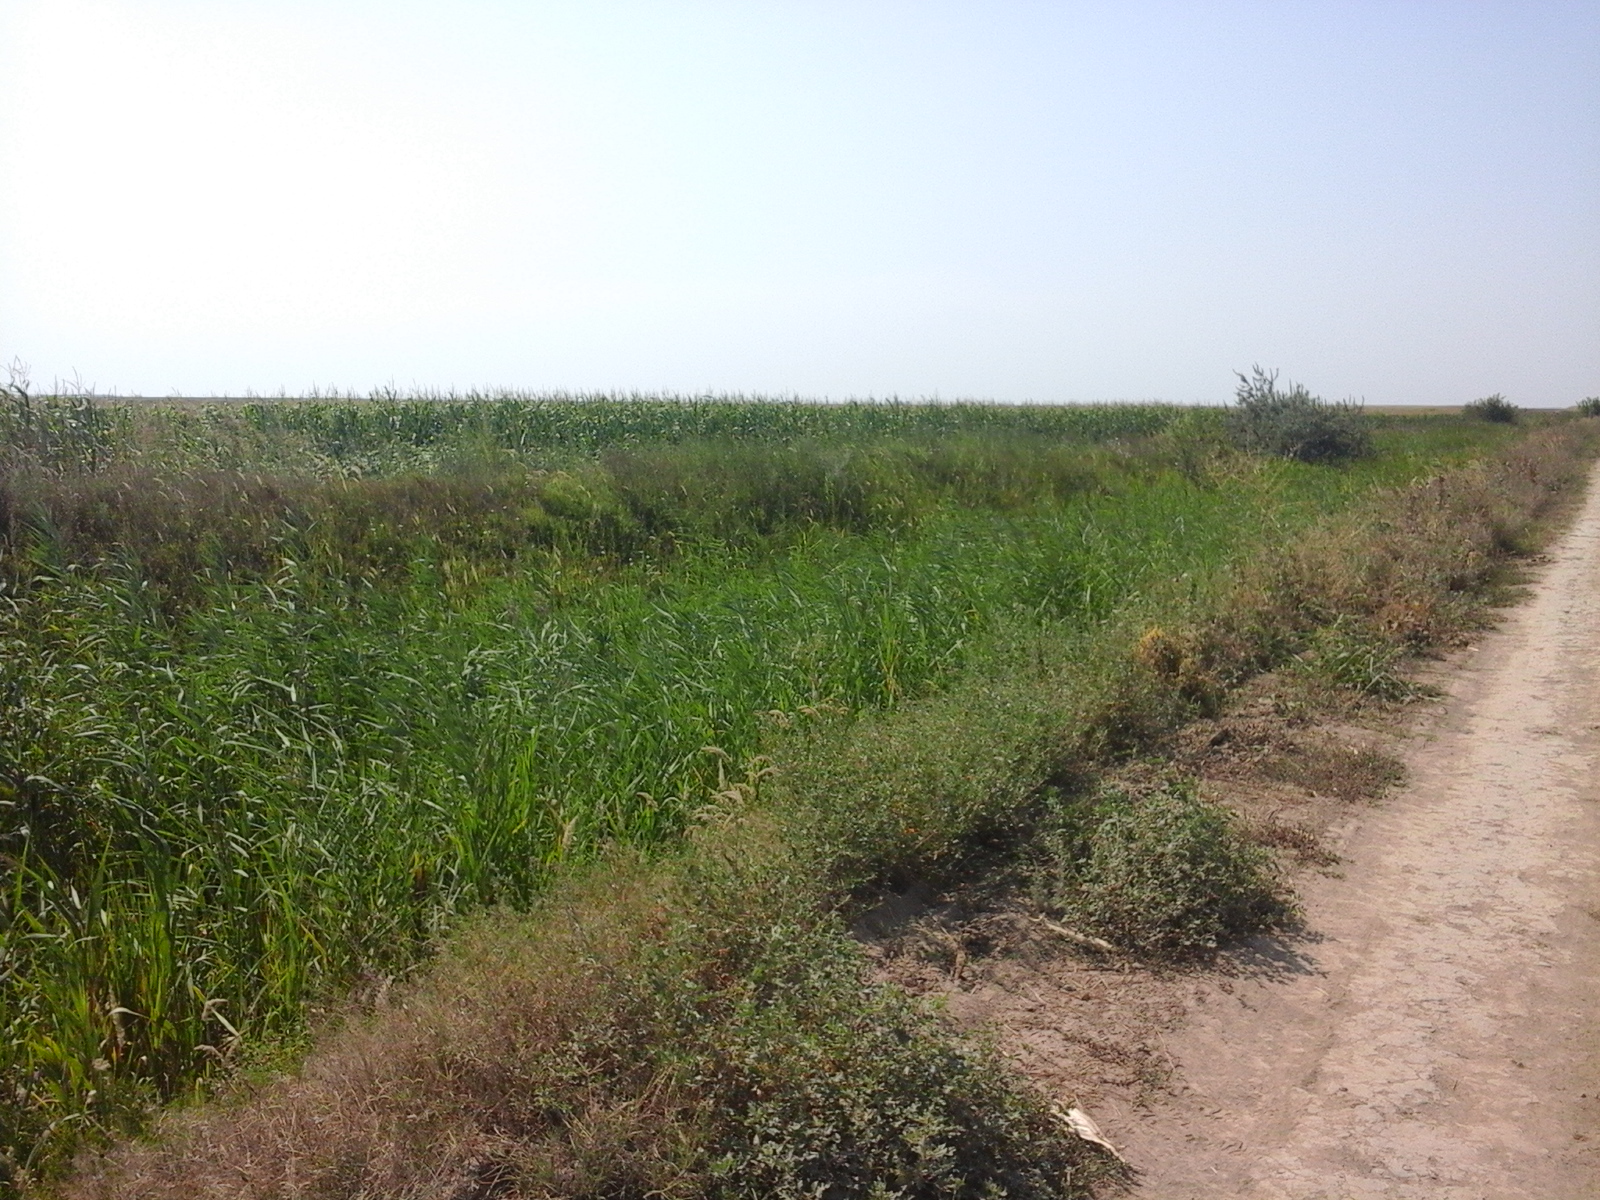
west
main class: Cropland
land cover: Maize
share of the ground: > 75 %
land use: Agriculture (excluding fallow land and kitchen gardens)
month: August
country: RO
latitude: 45.0593
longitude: 27.7182
